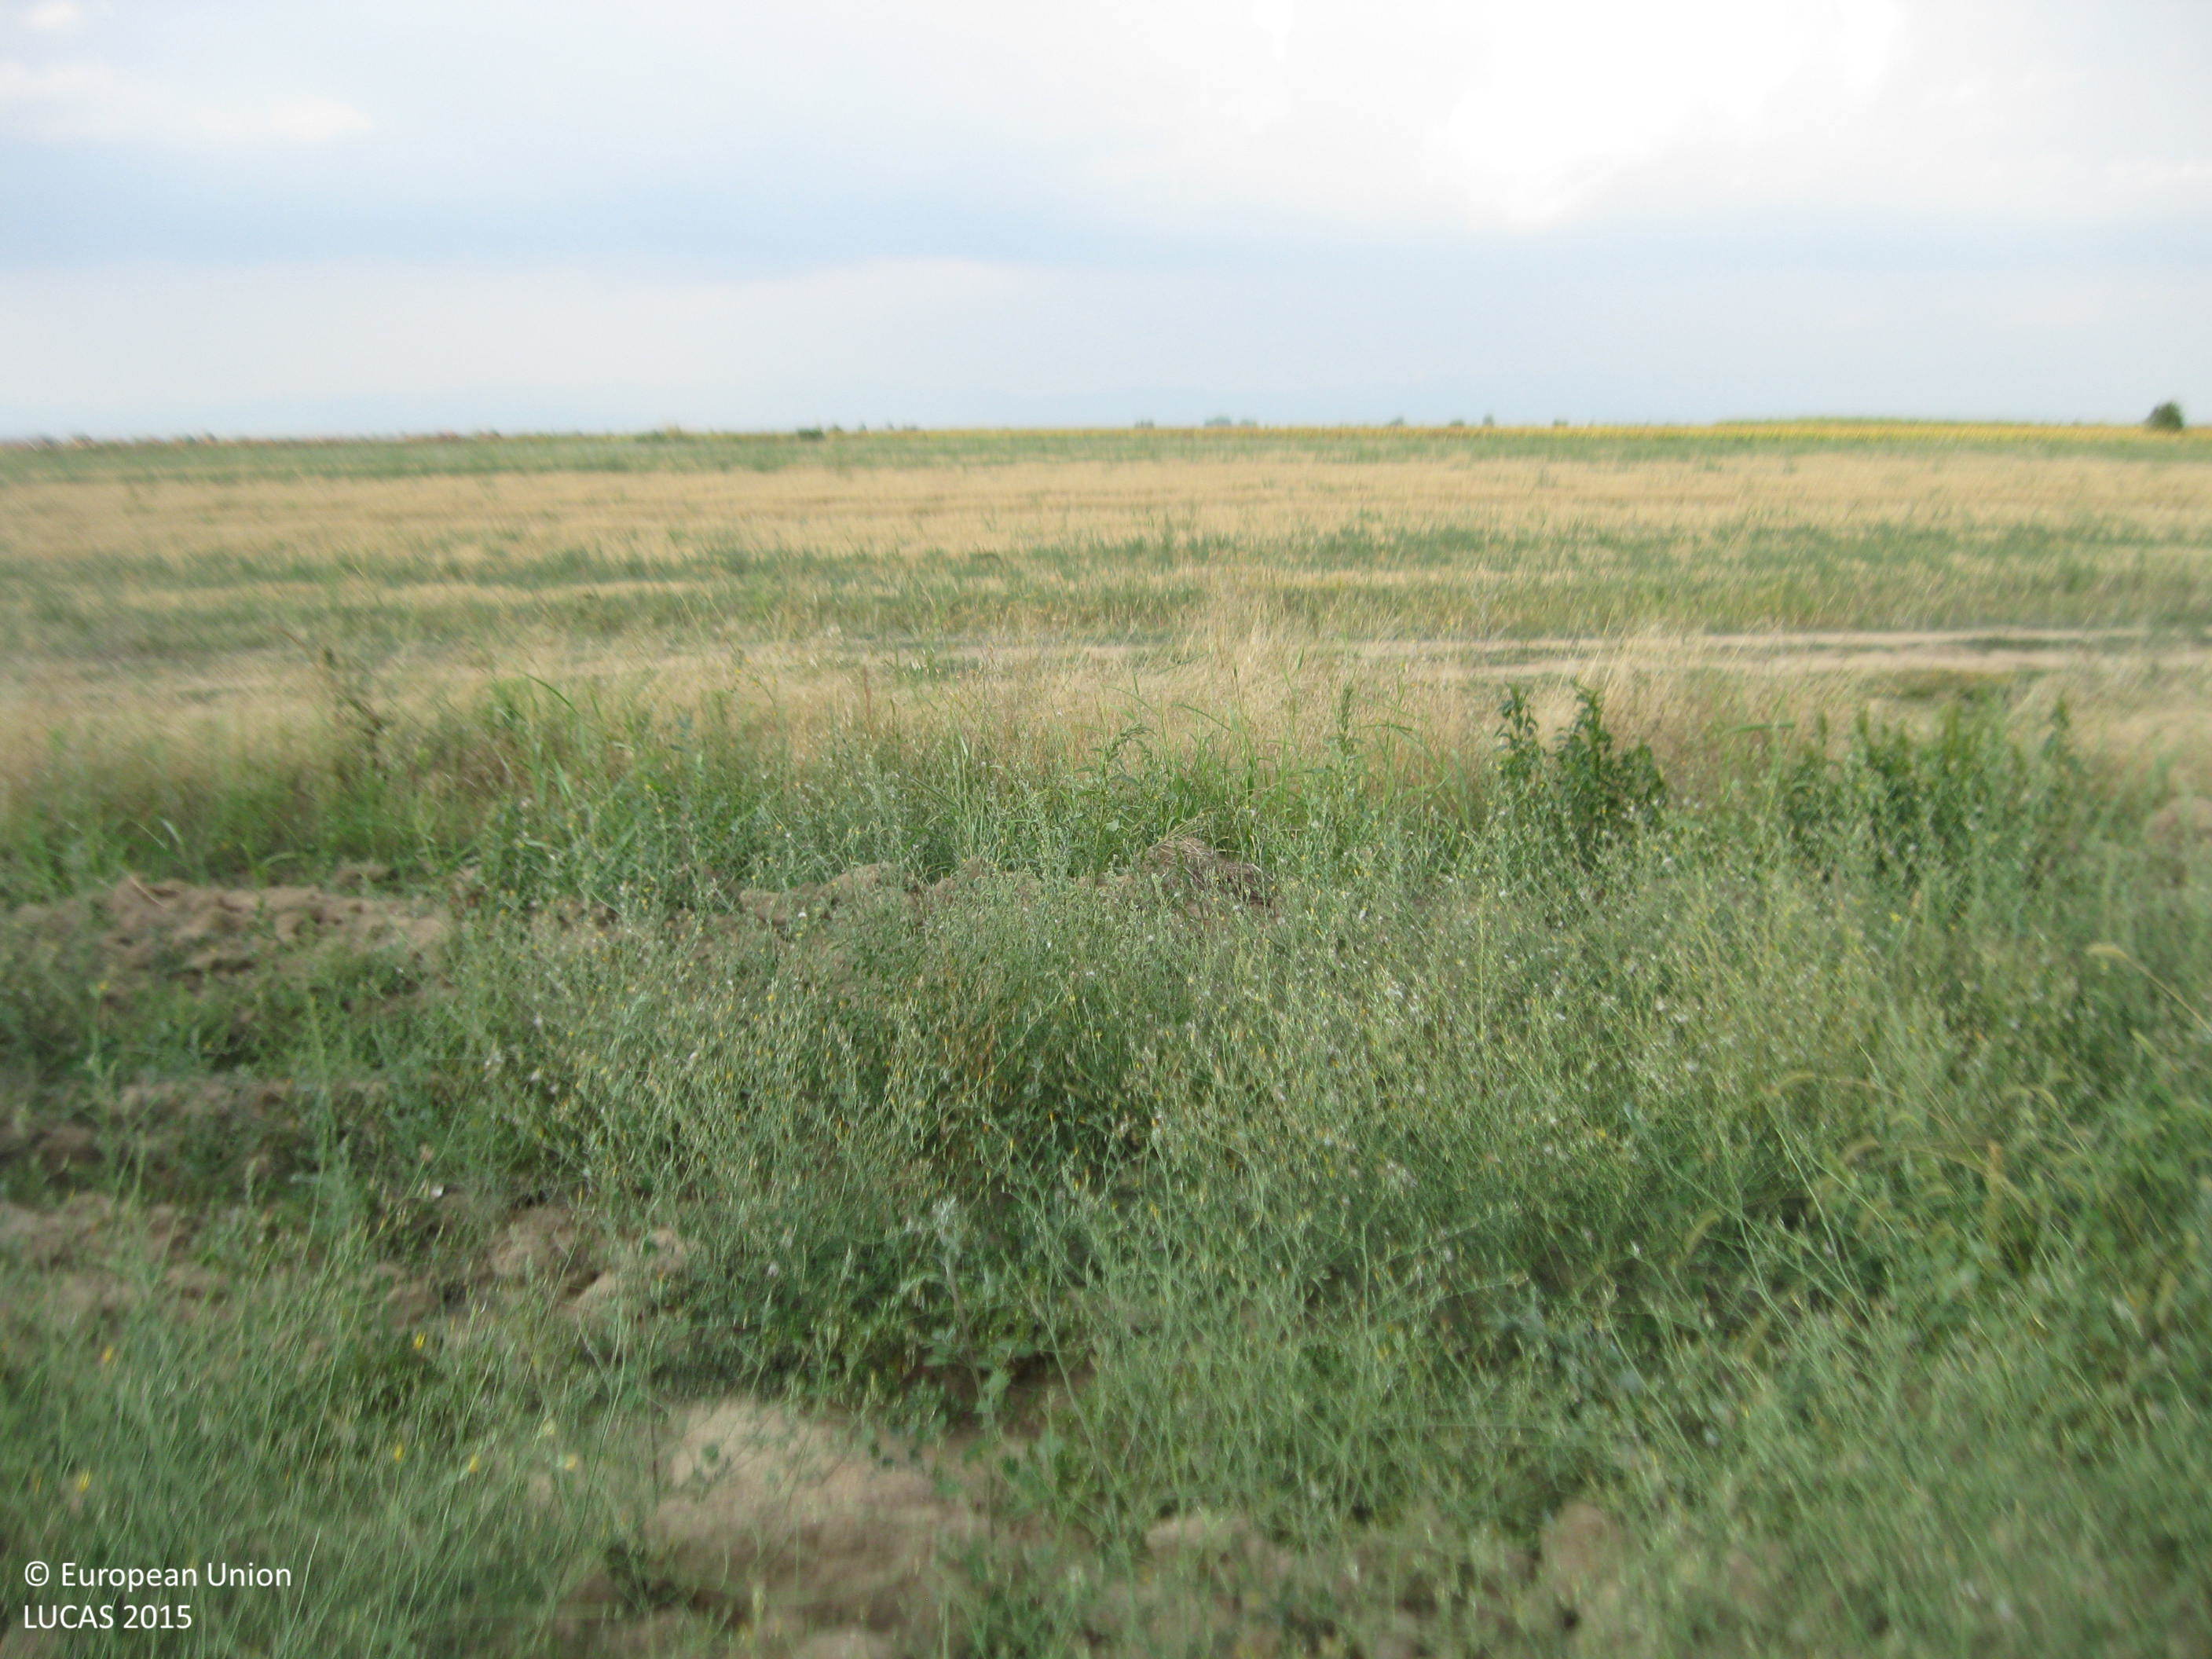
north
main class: Cropland
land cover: Oats
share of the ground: < 10 %
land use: Agriculture (excluding fallow land and kitchen gardens)
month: August
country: BG
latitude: 42.1599
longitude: 24.5846
